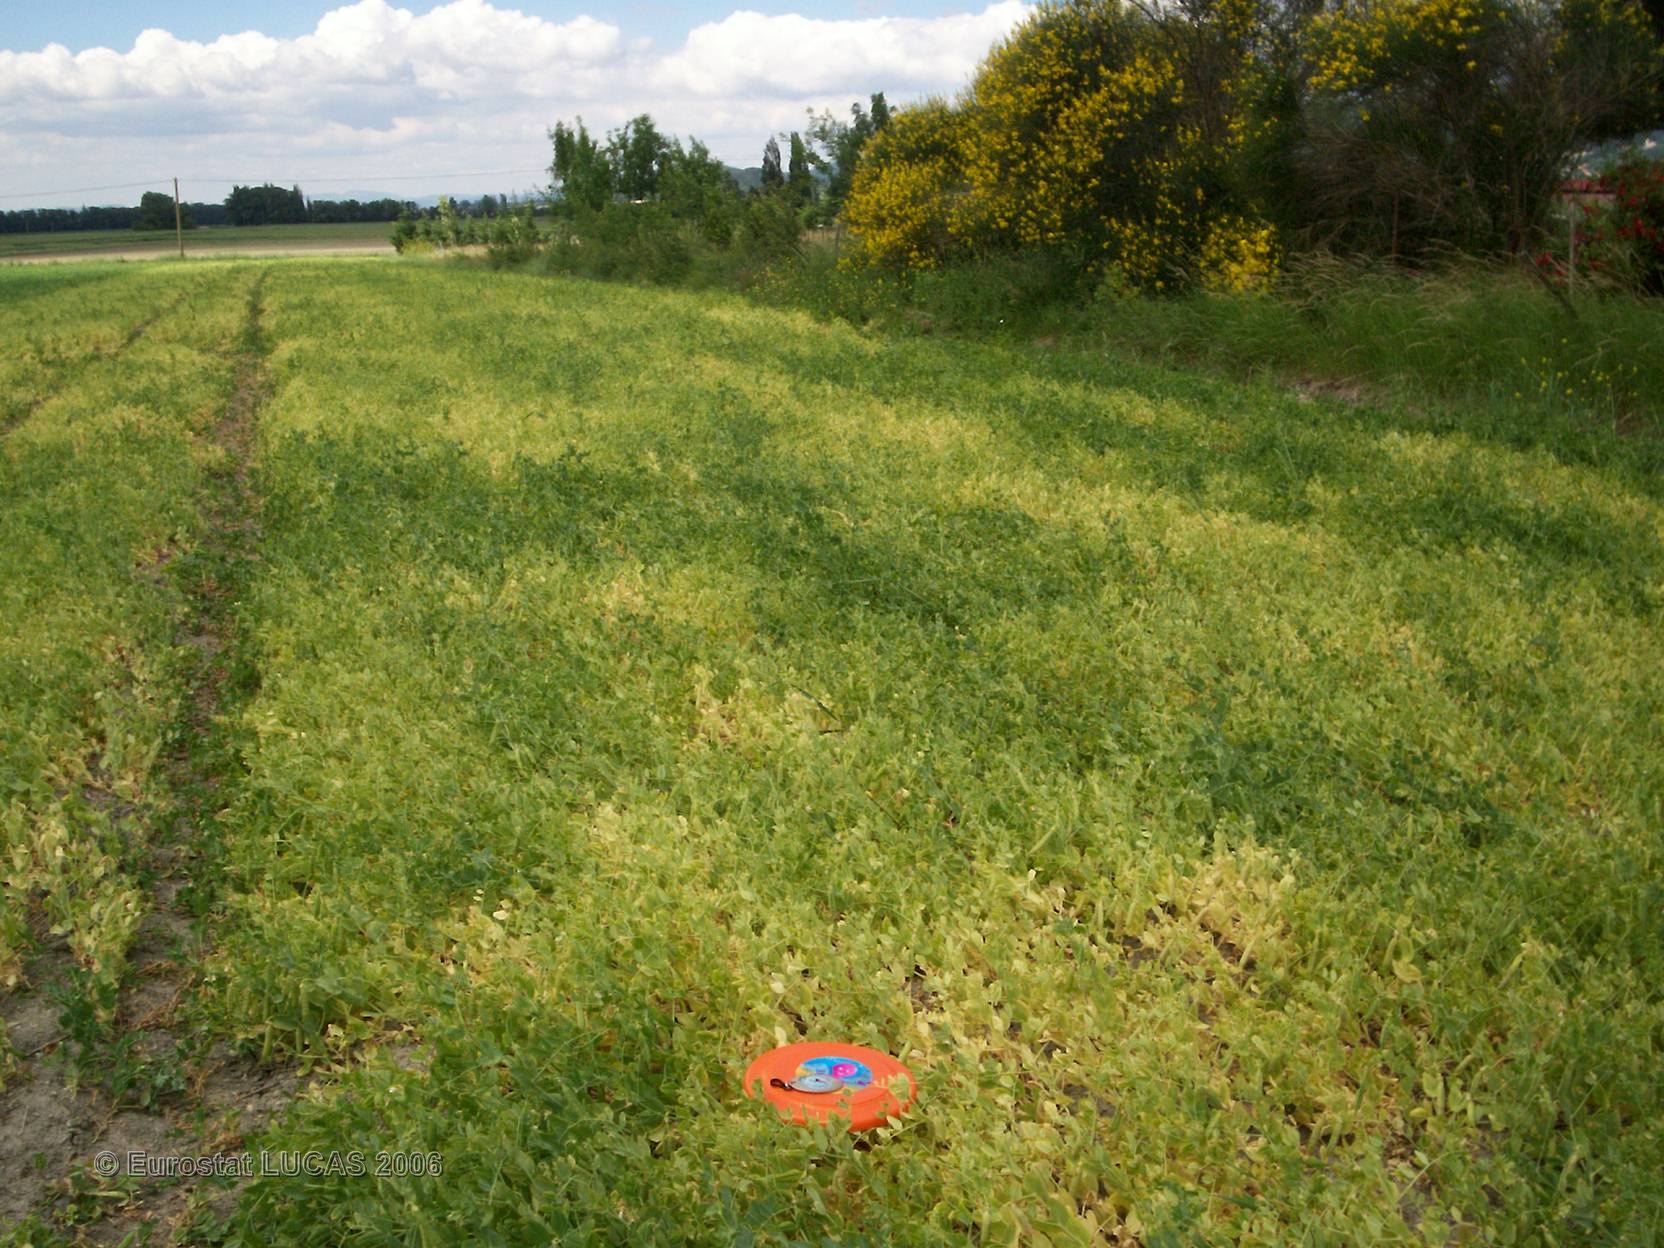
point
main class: Cropland
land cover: Dry pulses
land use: Agriculture (excluding fallow land and kitchen gardens)
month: May
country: FR
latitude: 44.6420
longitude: 4.9257
